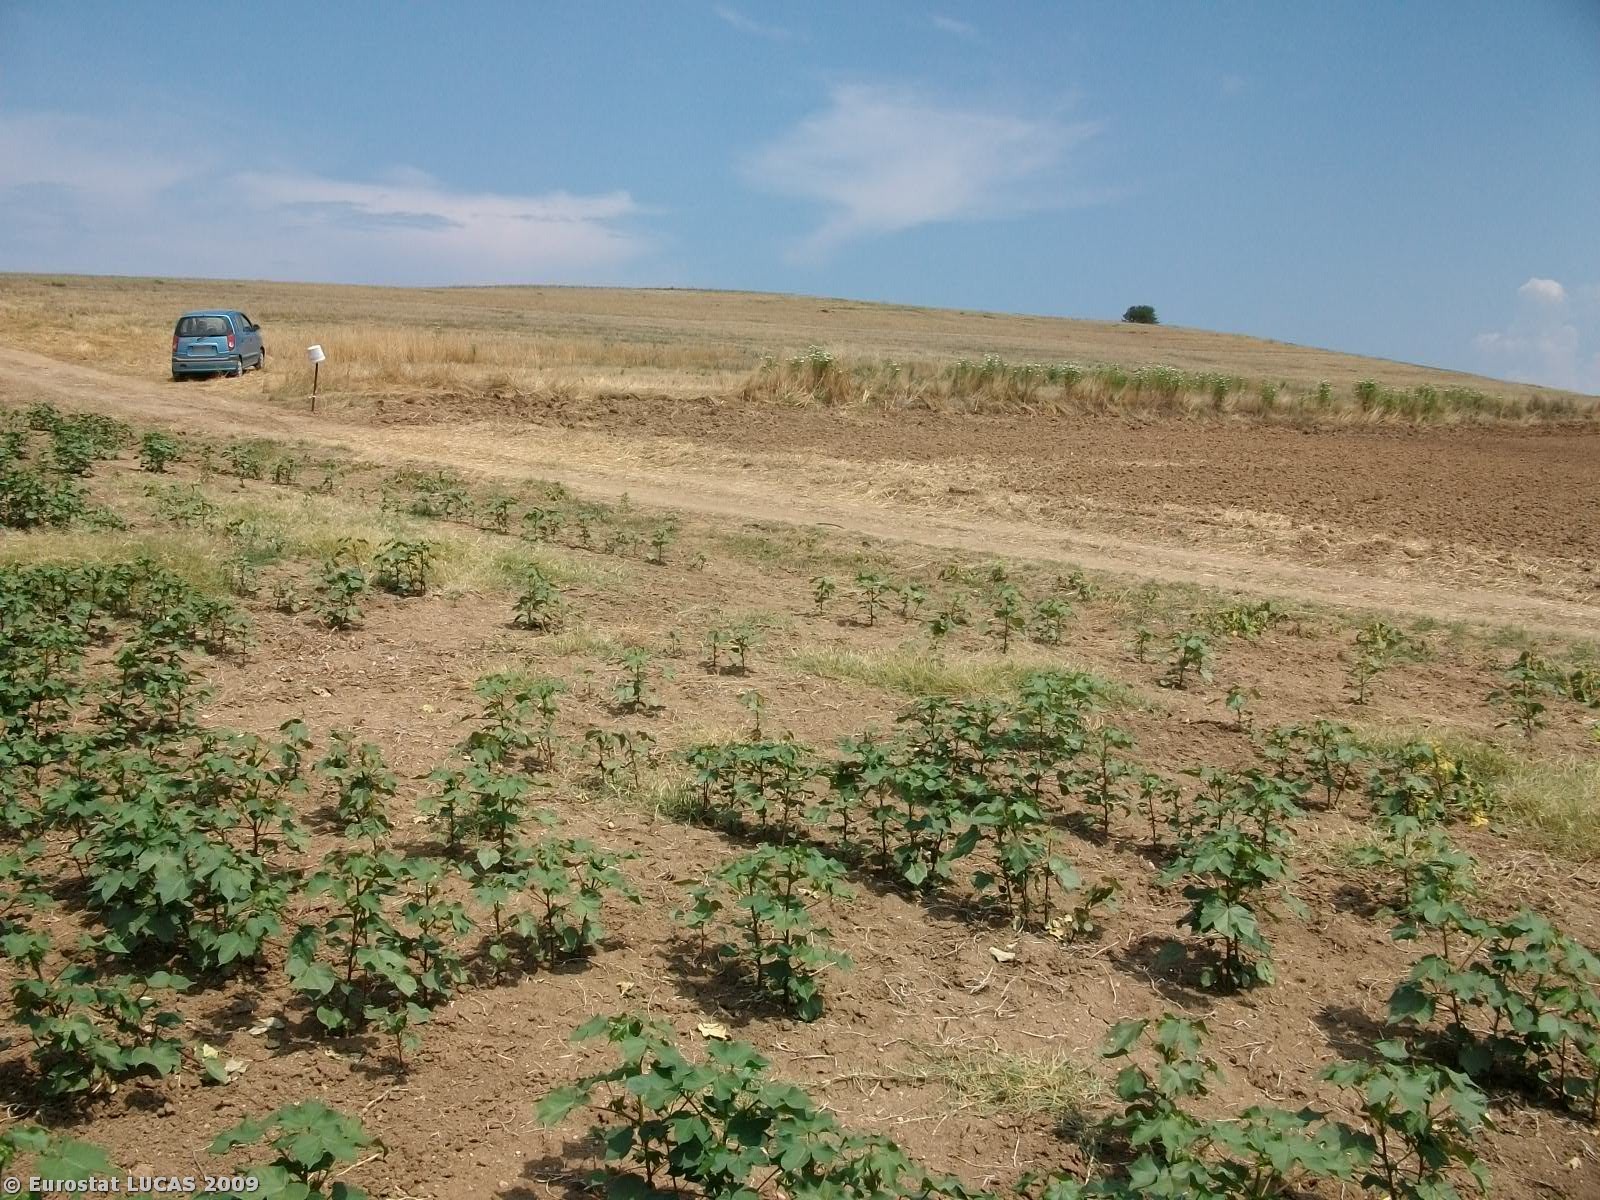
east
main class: Cropland
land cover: Cotton
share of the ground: 25 - 50 %
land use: Agriculture (excluding fallow land and kitchen gardens)
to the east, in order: Cotton; Grass margins; Tracks; Bare land; Grass margins; Durum wheat
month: July
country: GR
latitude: 40.1167
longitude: 23.3701
